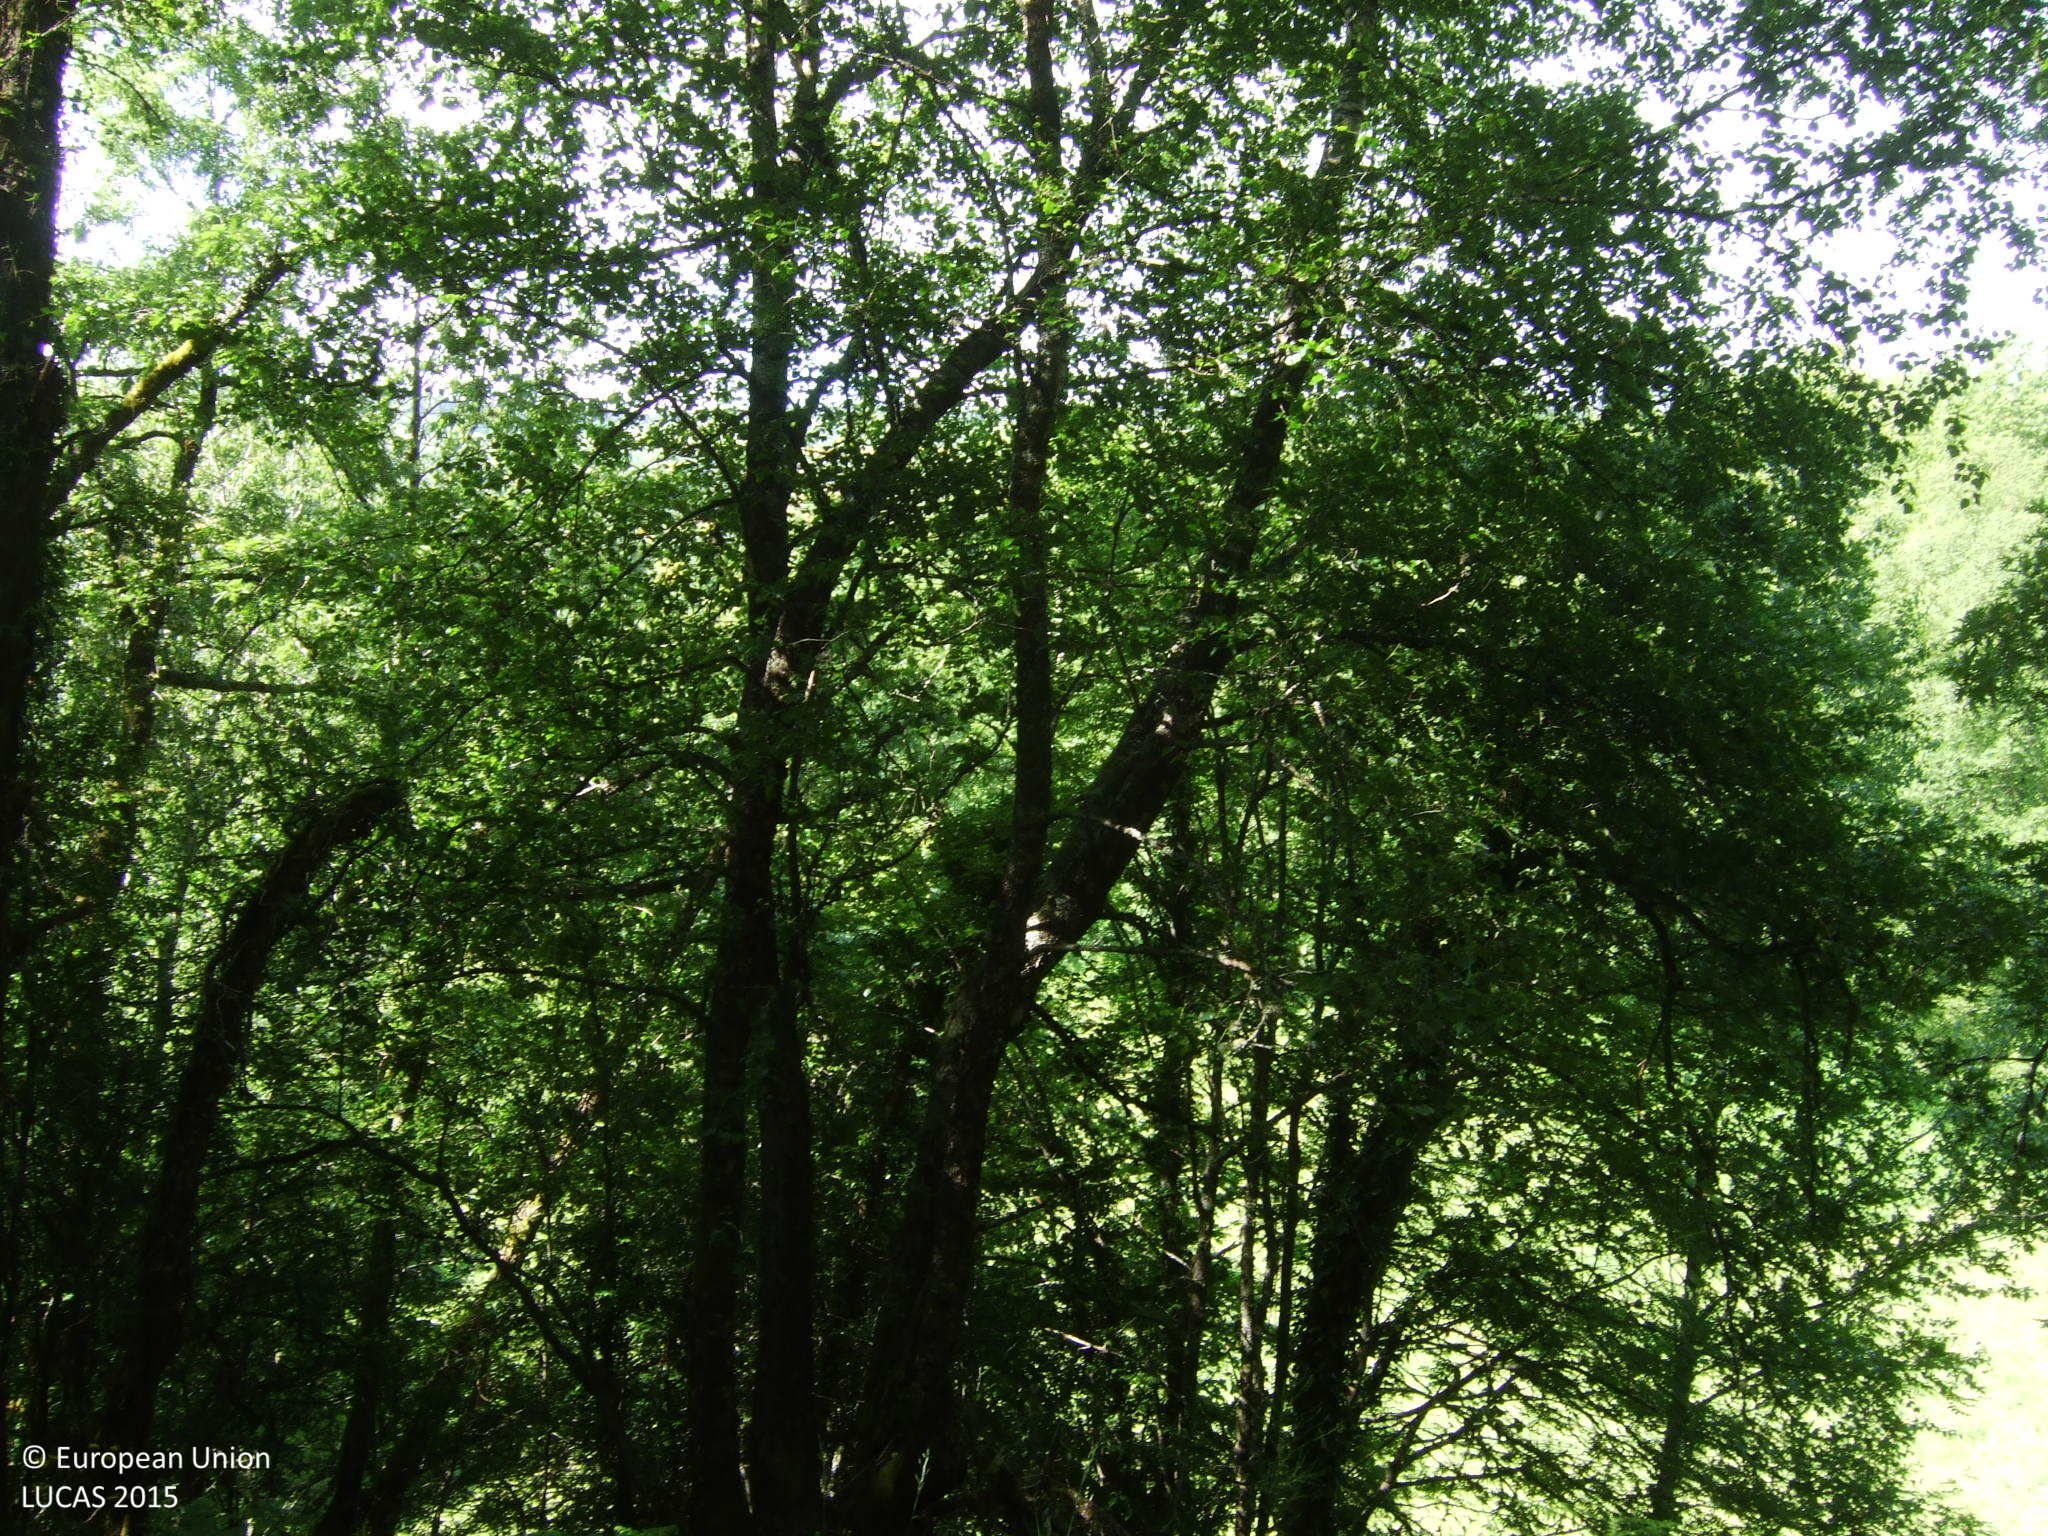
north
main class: Woodland
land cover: Broadleaved woodland
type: acidophilous oak and oak-birch forest
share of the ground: > 75 %
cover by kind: broadleaved forest trees 80 %, shrubs 20 %
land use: Semi-natural and natural areas not in use
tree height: > 5 m
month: June
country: ES
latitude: 42.6855
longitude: -7.0610
